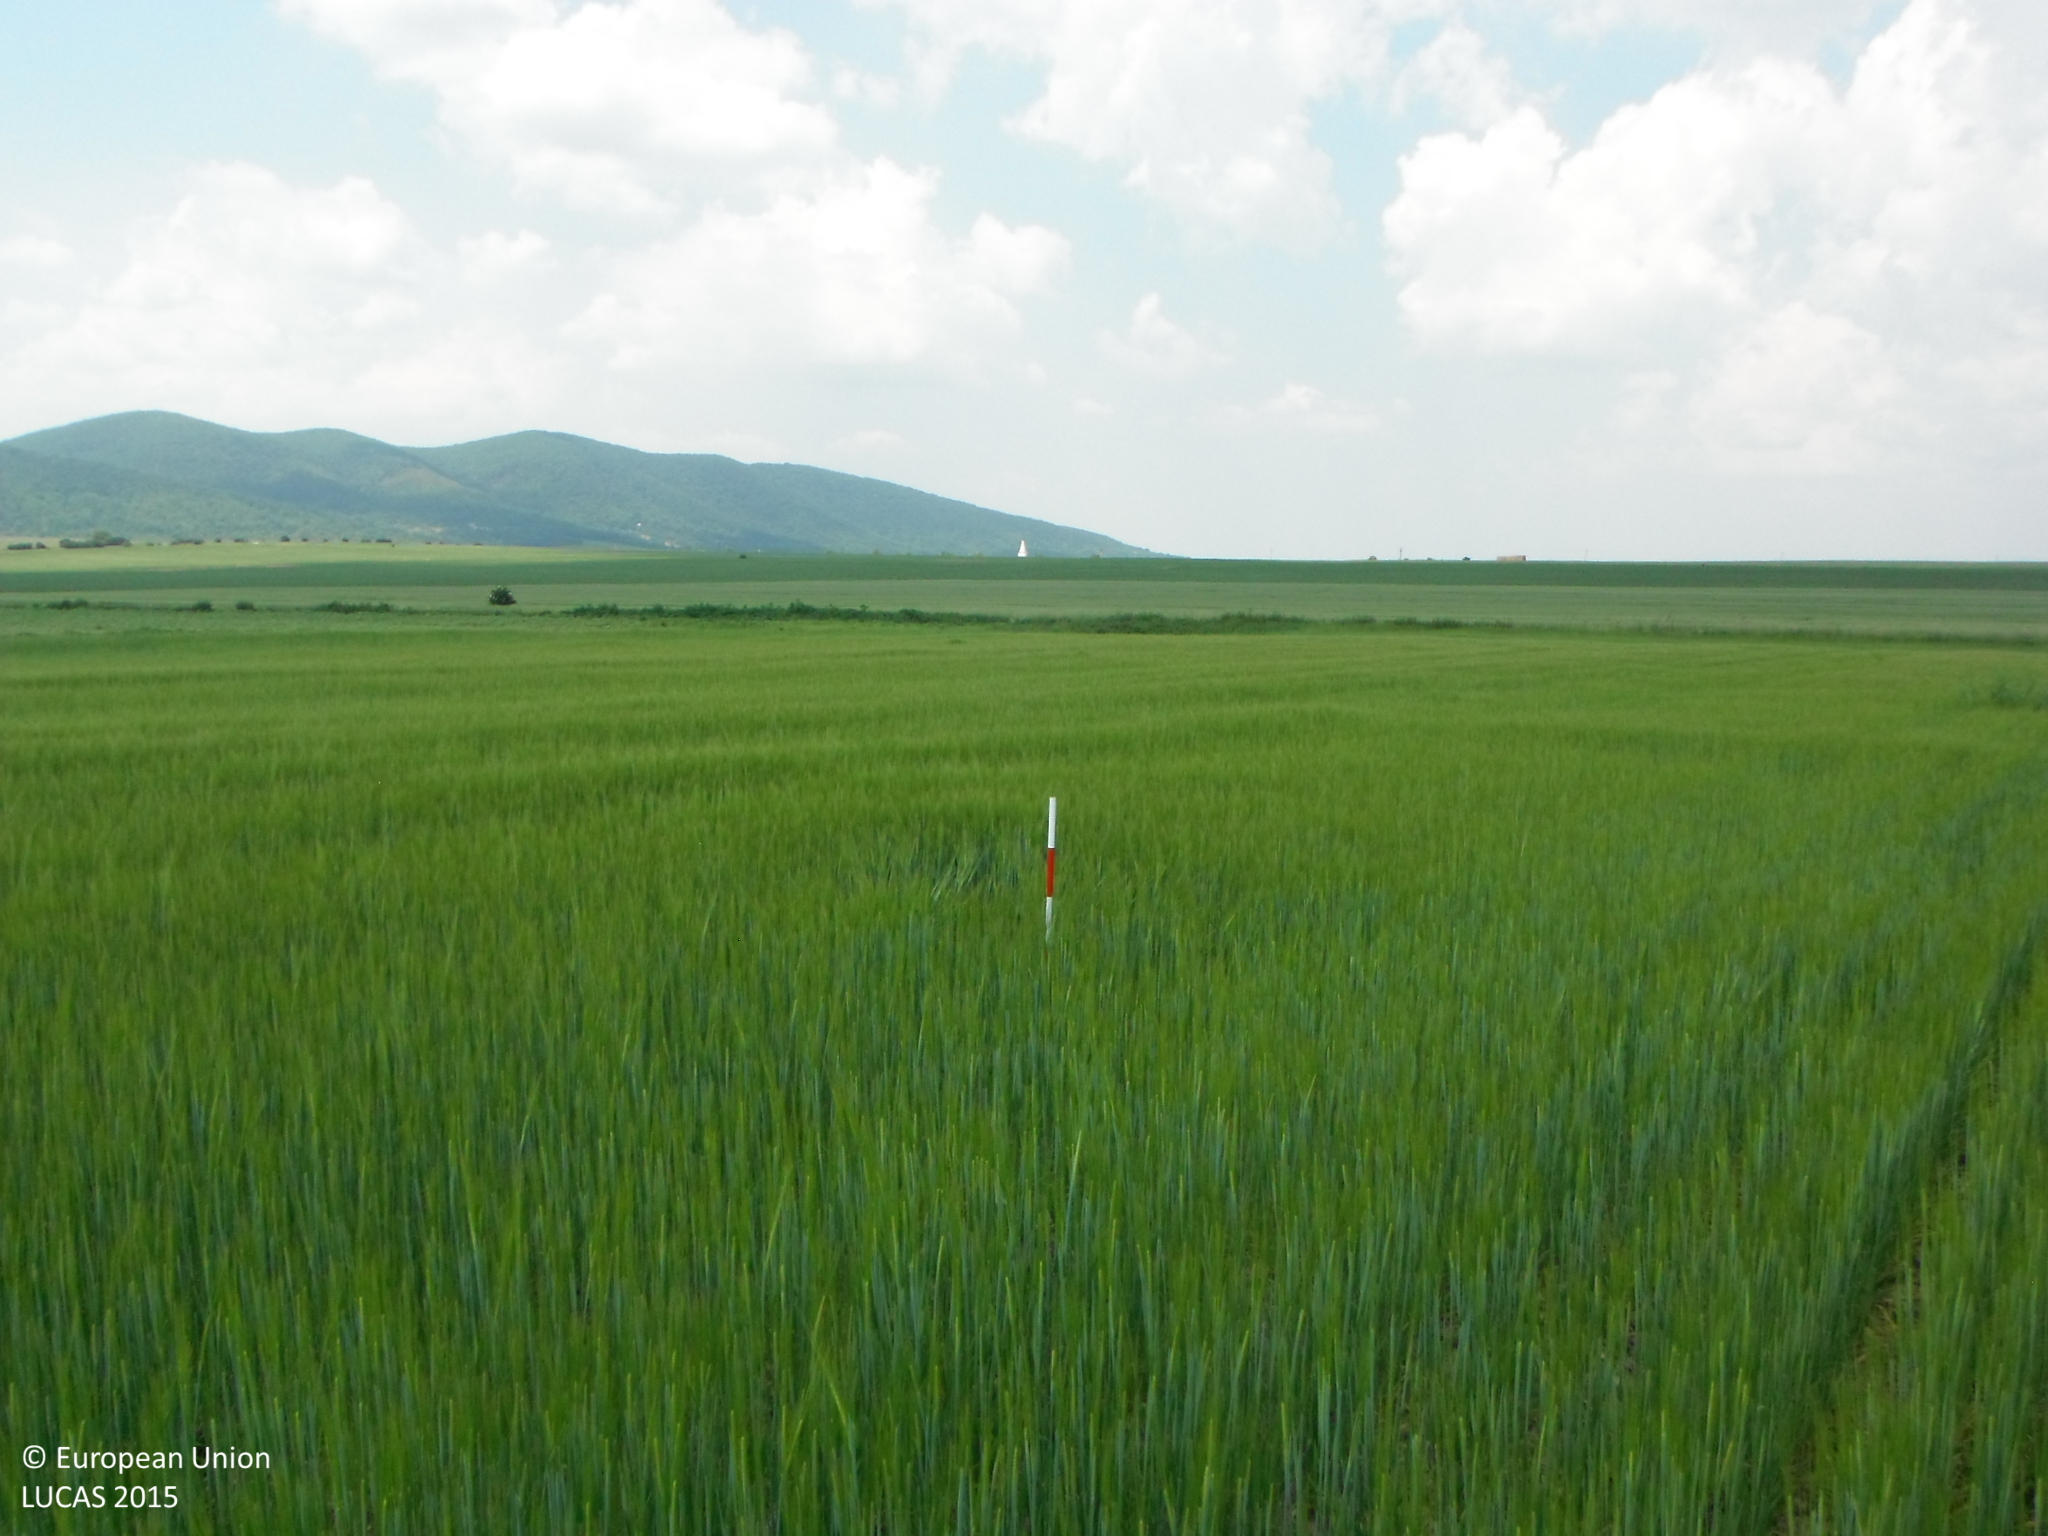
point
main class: Cropland
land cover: Barley
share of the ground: > 75 %
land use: Agriculture (excluding fallow land and kitchen gardens)
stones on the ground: < 10 %
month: June
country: SK
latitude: 48.4244
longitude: 17.4291
